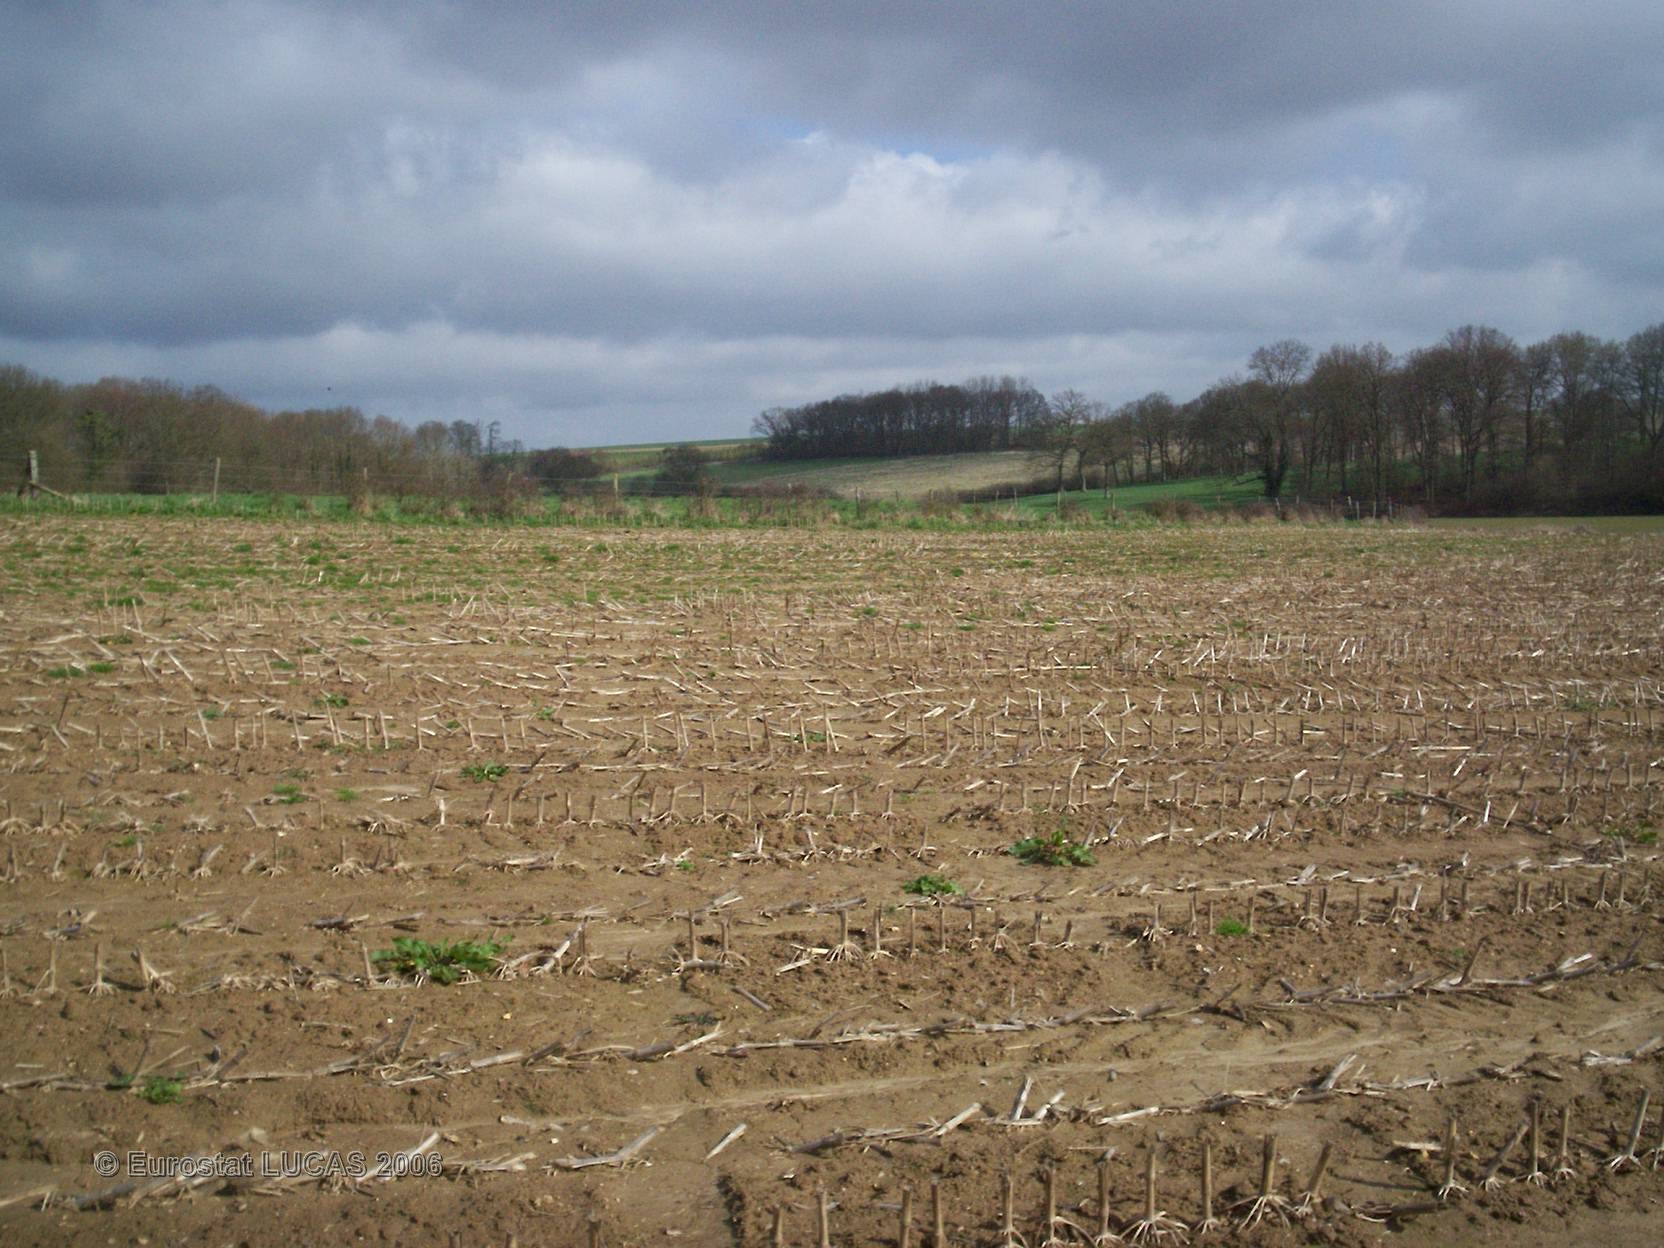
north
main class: Cropland
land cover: Maize
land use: Agriculture (excluding fallow land and kitchen gardens)
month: May
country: FR
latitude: 49.7395
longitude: 0.8037
